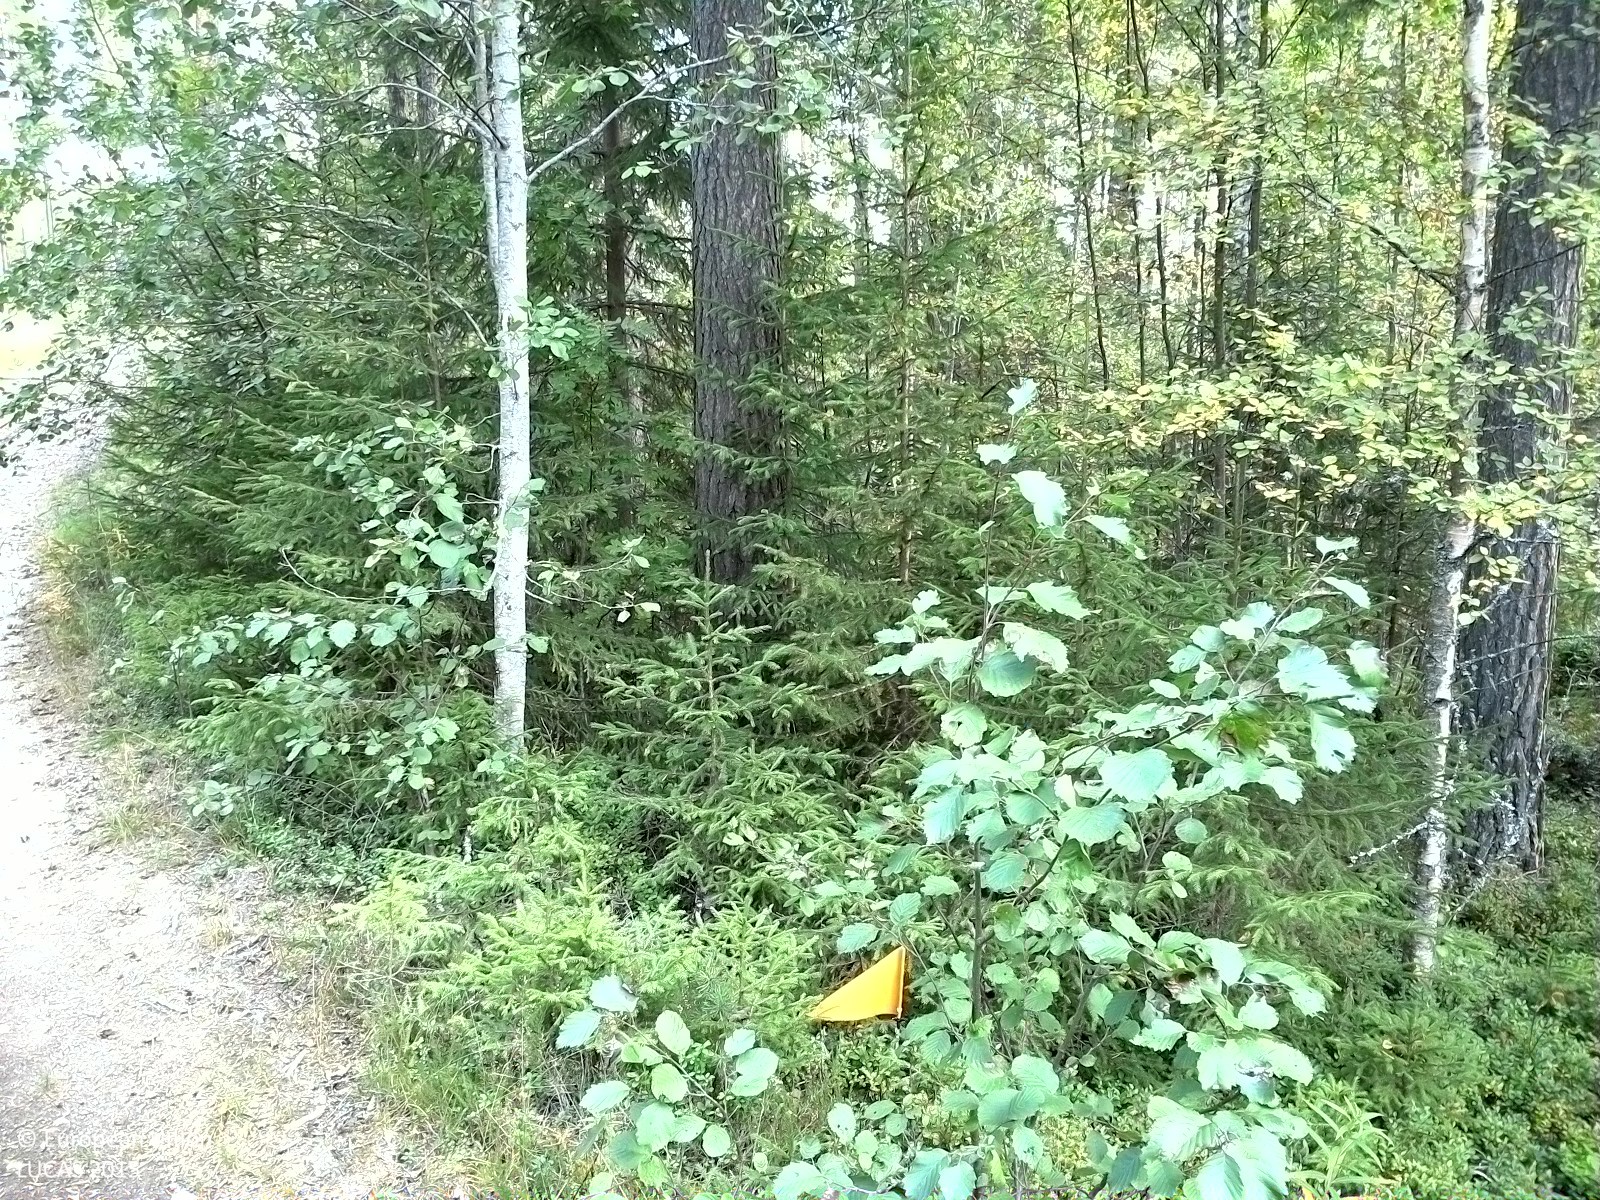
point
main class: Woodland
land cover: Spruce dominated mixed woodland
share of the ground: > 75 %
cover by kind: coniferous forest trees 40 %, broadleaved forest trees 35 %, shrubs 25 %
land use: Forestry
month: September
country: SE
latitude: 62.6035
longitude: 16.3876
